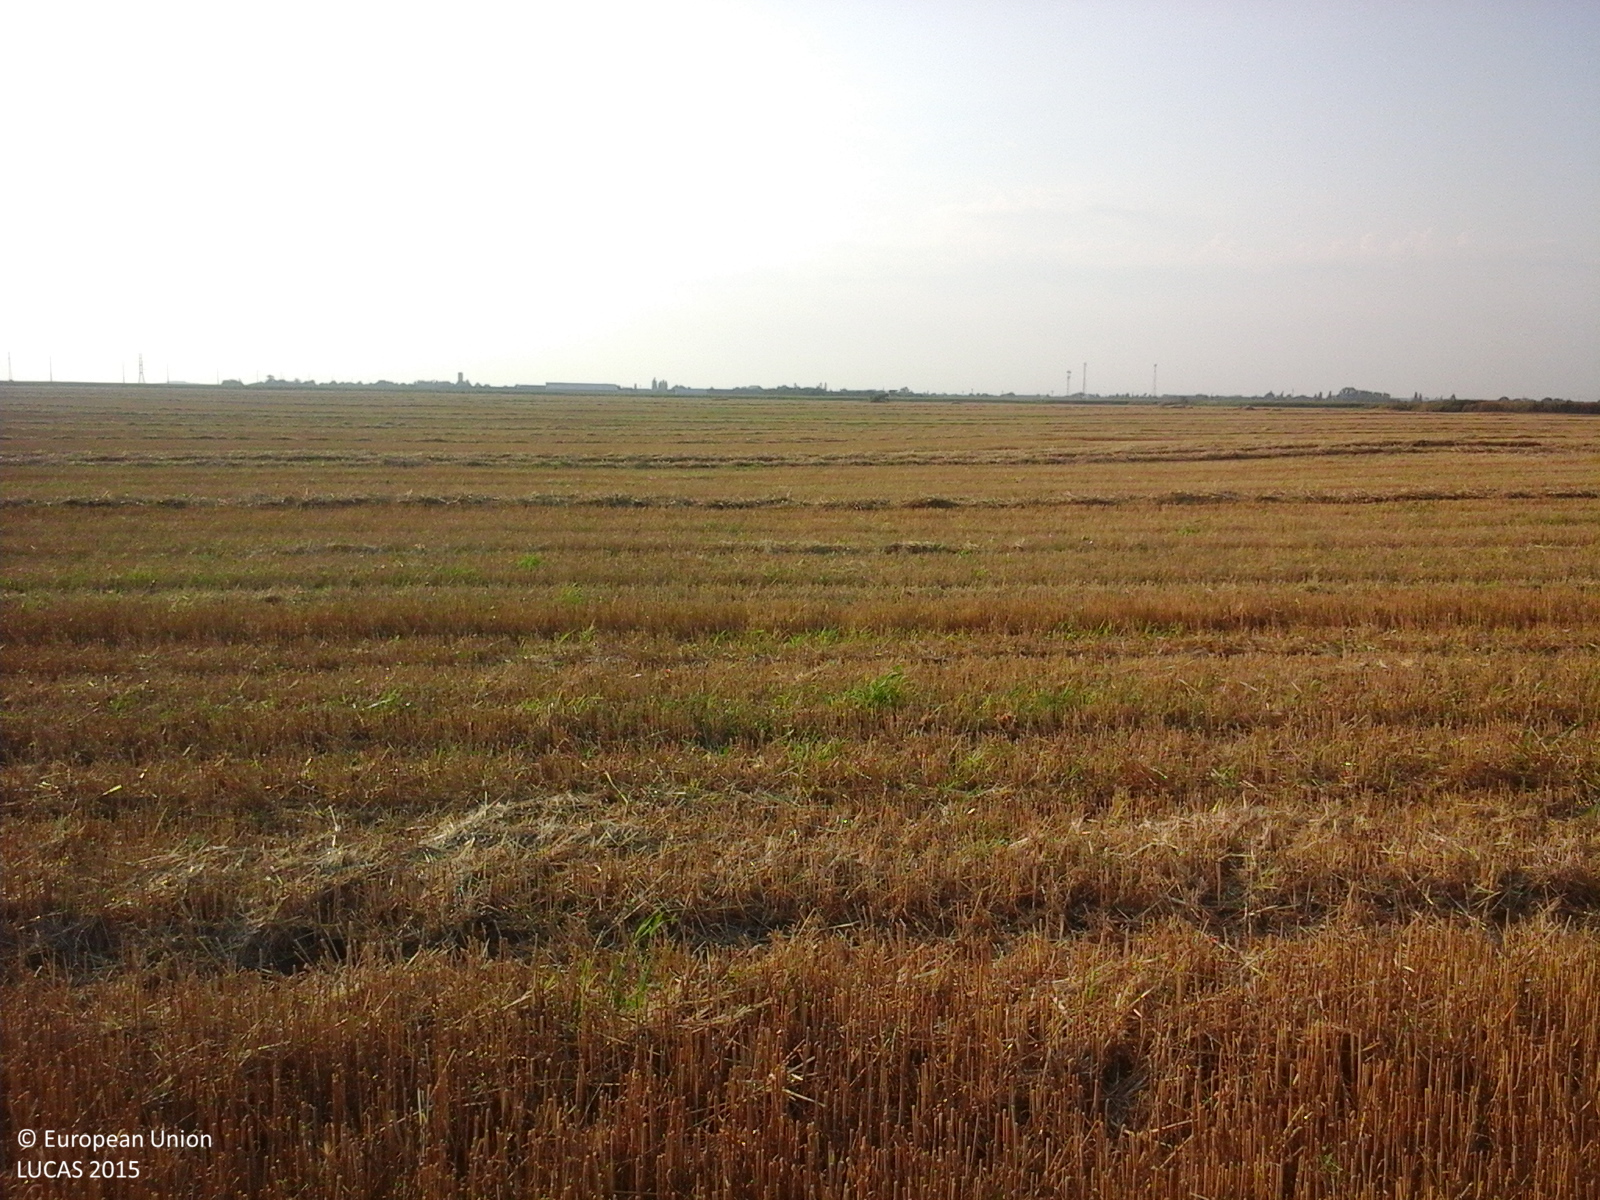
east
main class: Cropland
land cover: Durum wheat
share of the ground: 25 - 50 %
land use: Agriculture (excluding fallow land and kitchen gardens)
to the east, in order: Durum wheat
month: July
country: RO
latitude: 44.5888
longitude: 27.1254
